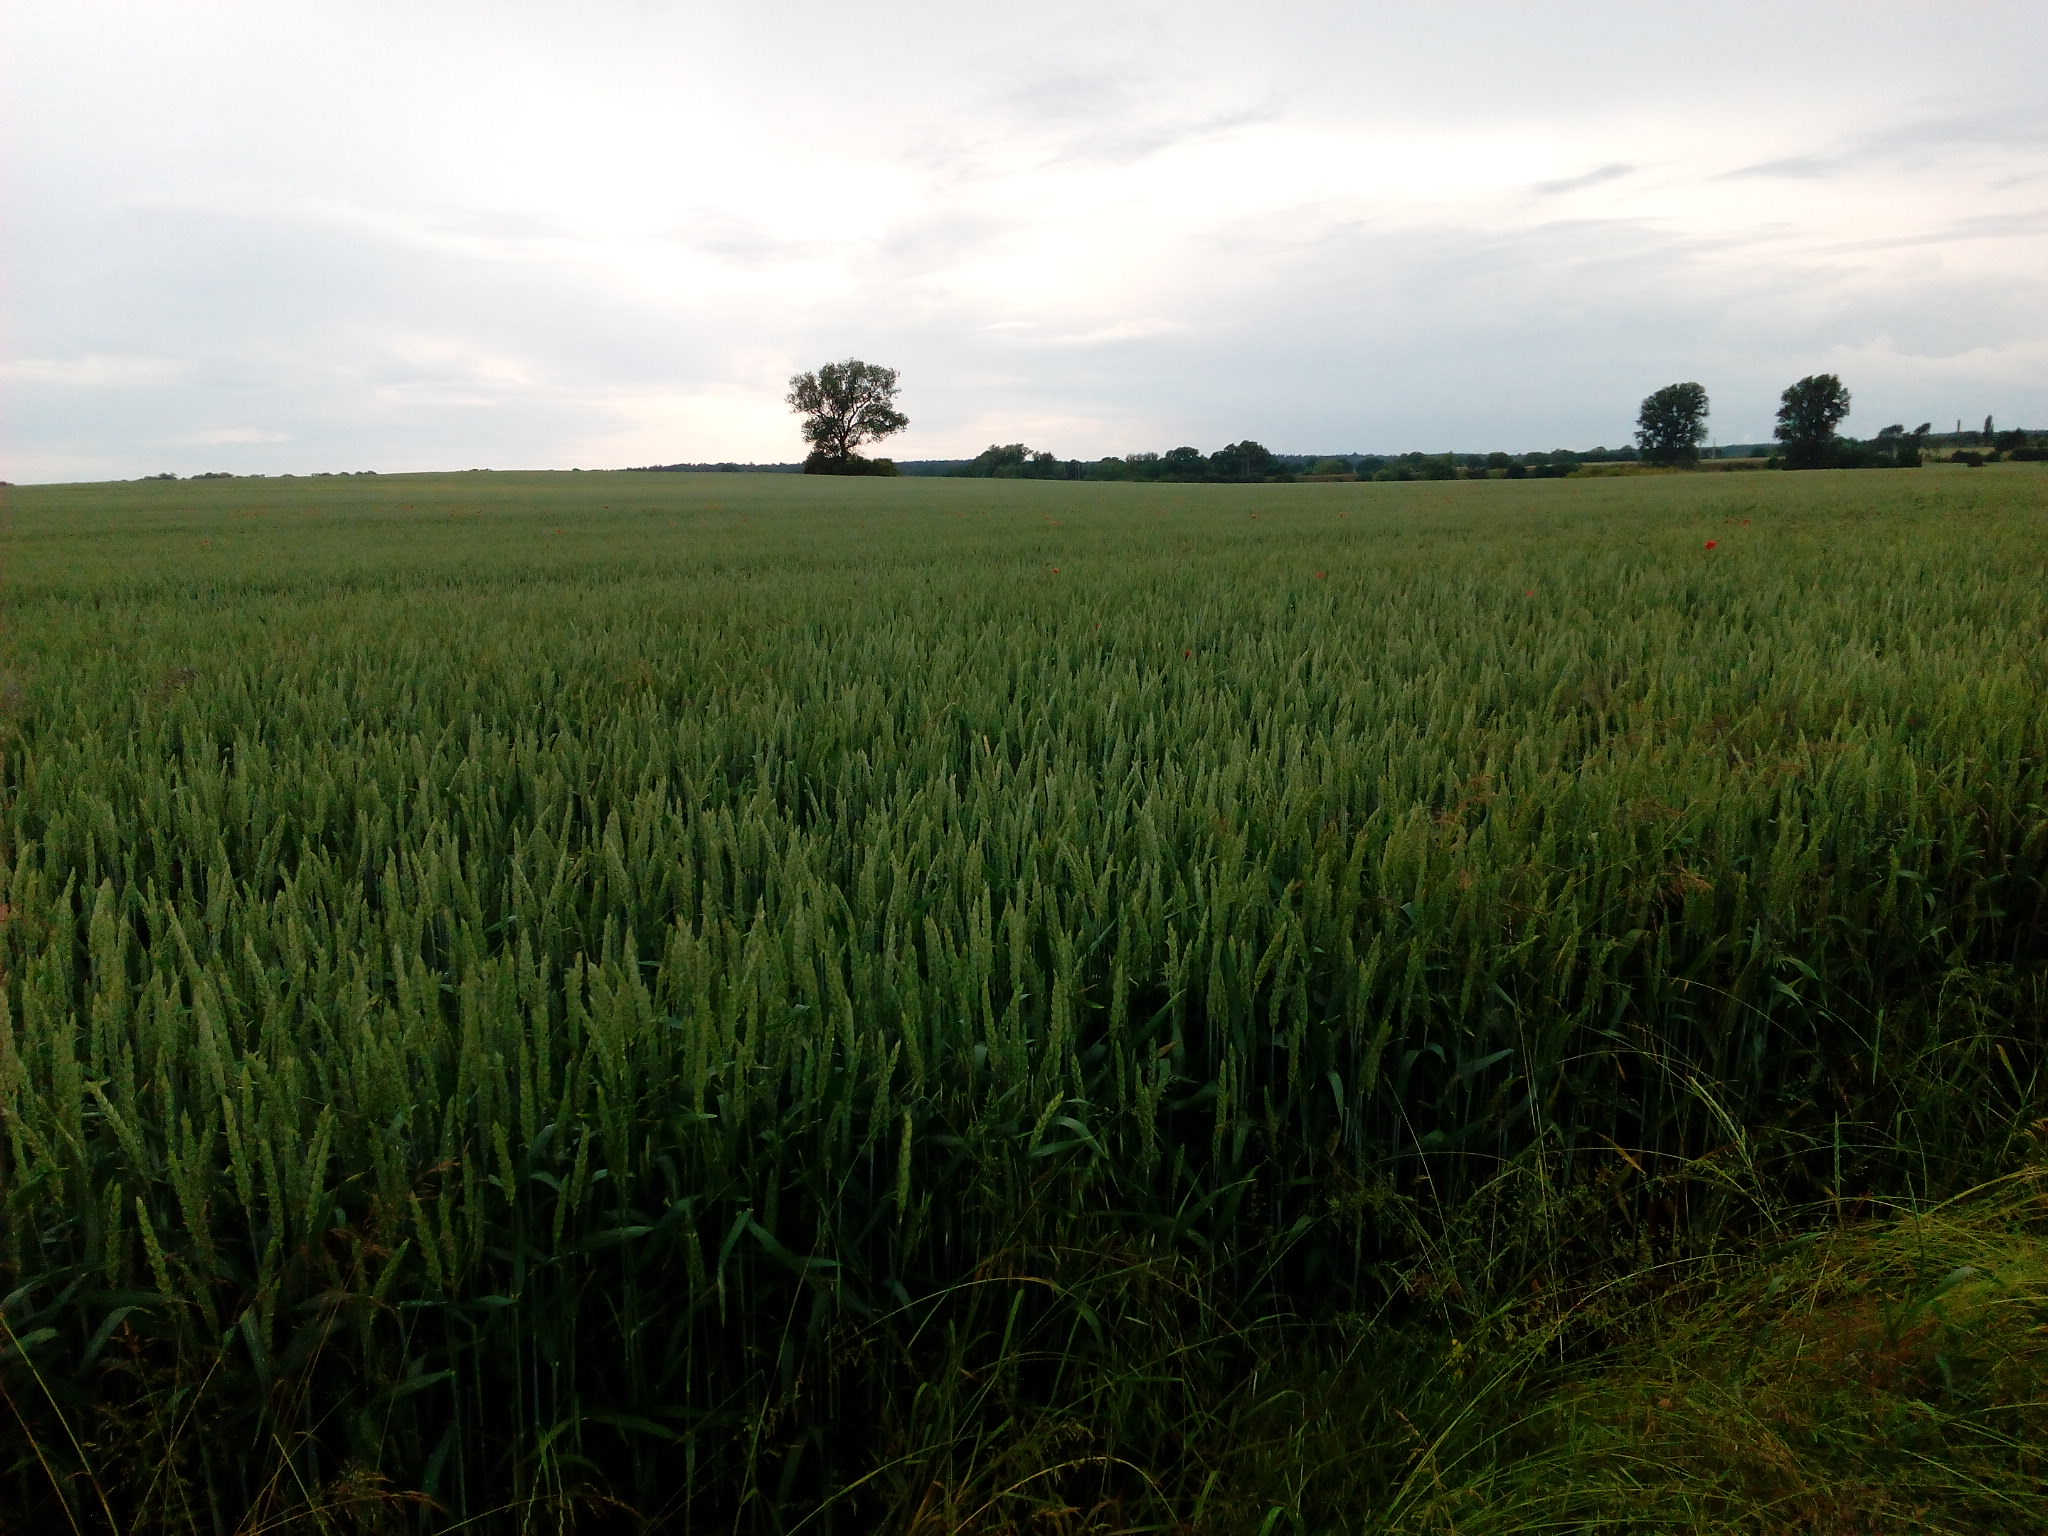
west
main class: Cropland
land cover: Common wheat
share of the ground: > 75 %
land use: Agriculture (excluding fallow land and kitchen gardens)
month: June
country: DE
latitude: 52.9827
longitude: 13.1723
